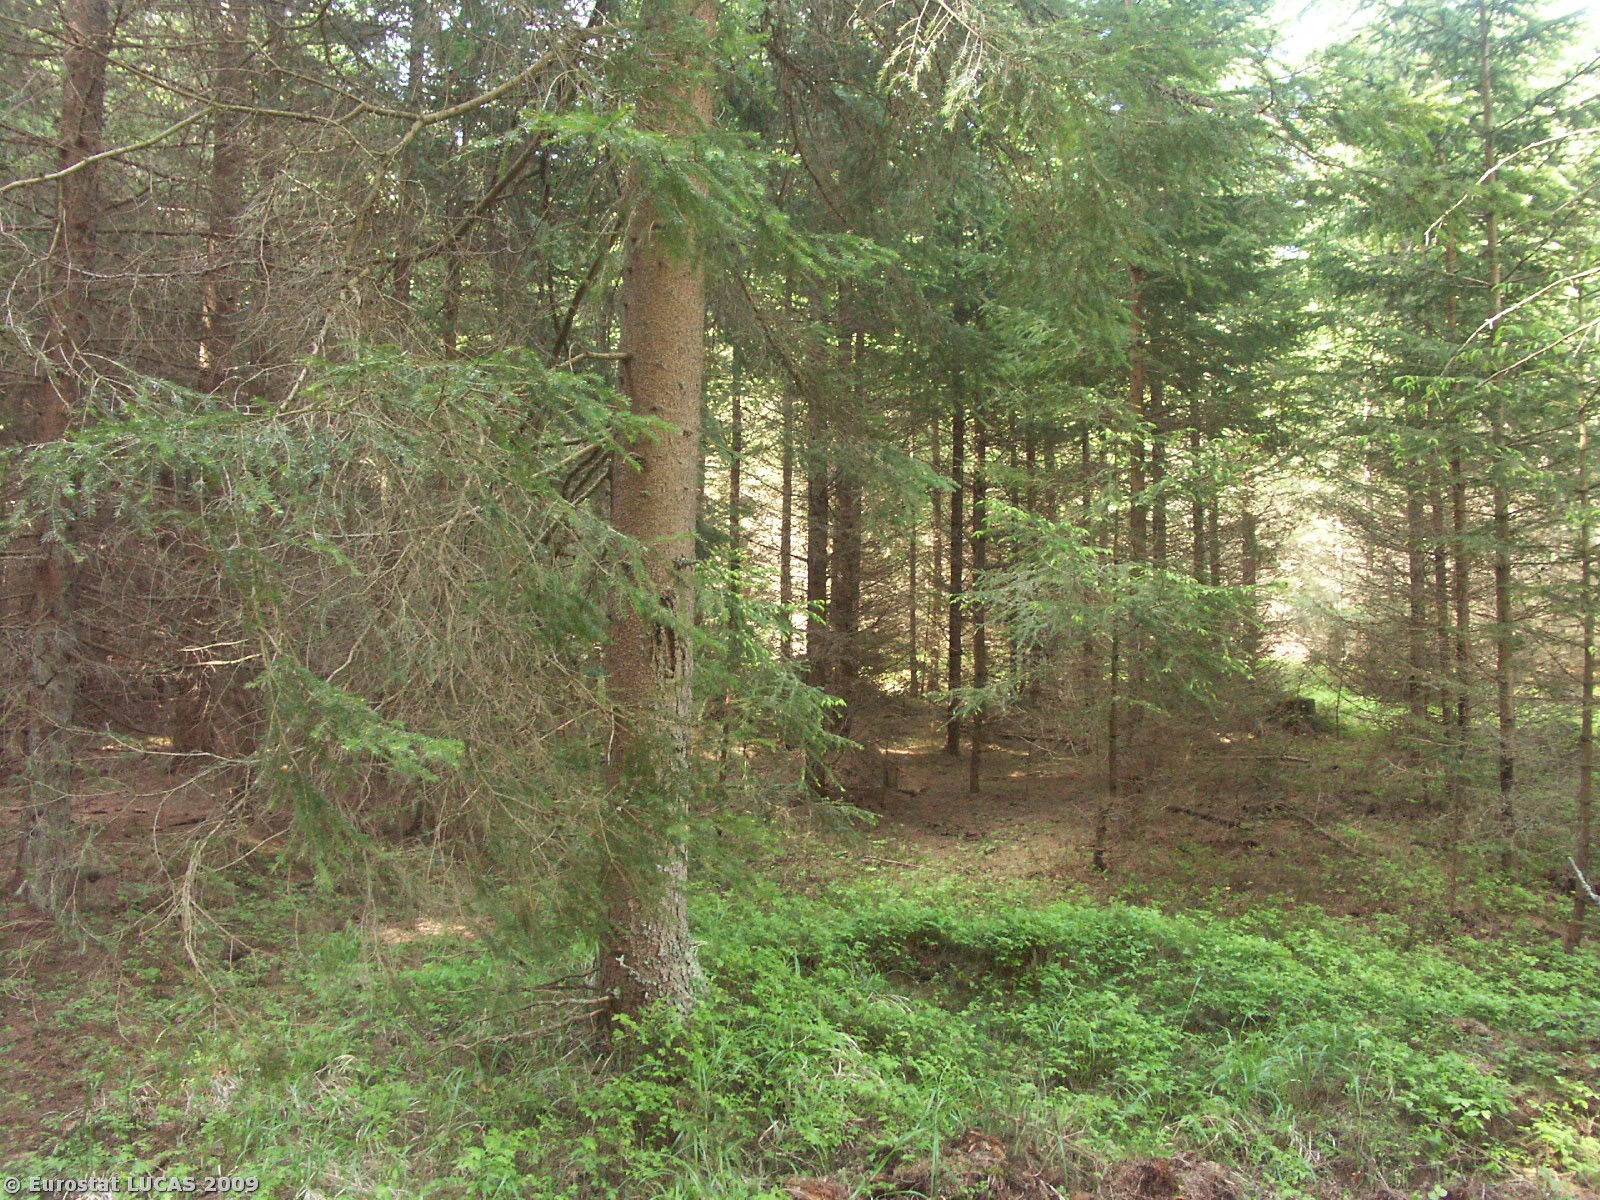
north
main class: Woodland
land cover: Coniferous woodland
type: hemiboreal forest and nemoral coniferous forest and mixed broadleaved-coniferous forest
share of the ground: > 75 %
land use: Forestry
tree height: > 5 m
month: May
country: CZ
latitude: 48.6490
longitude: 14.6296
